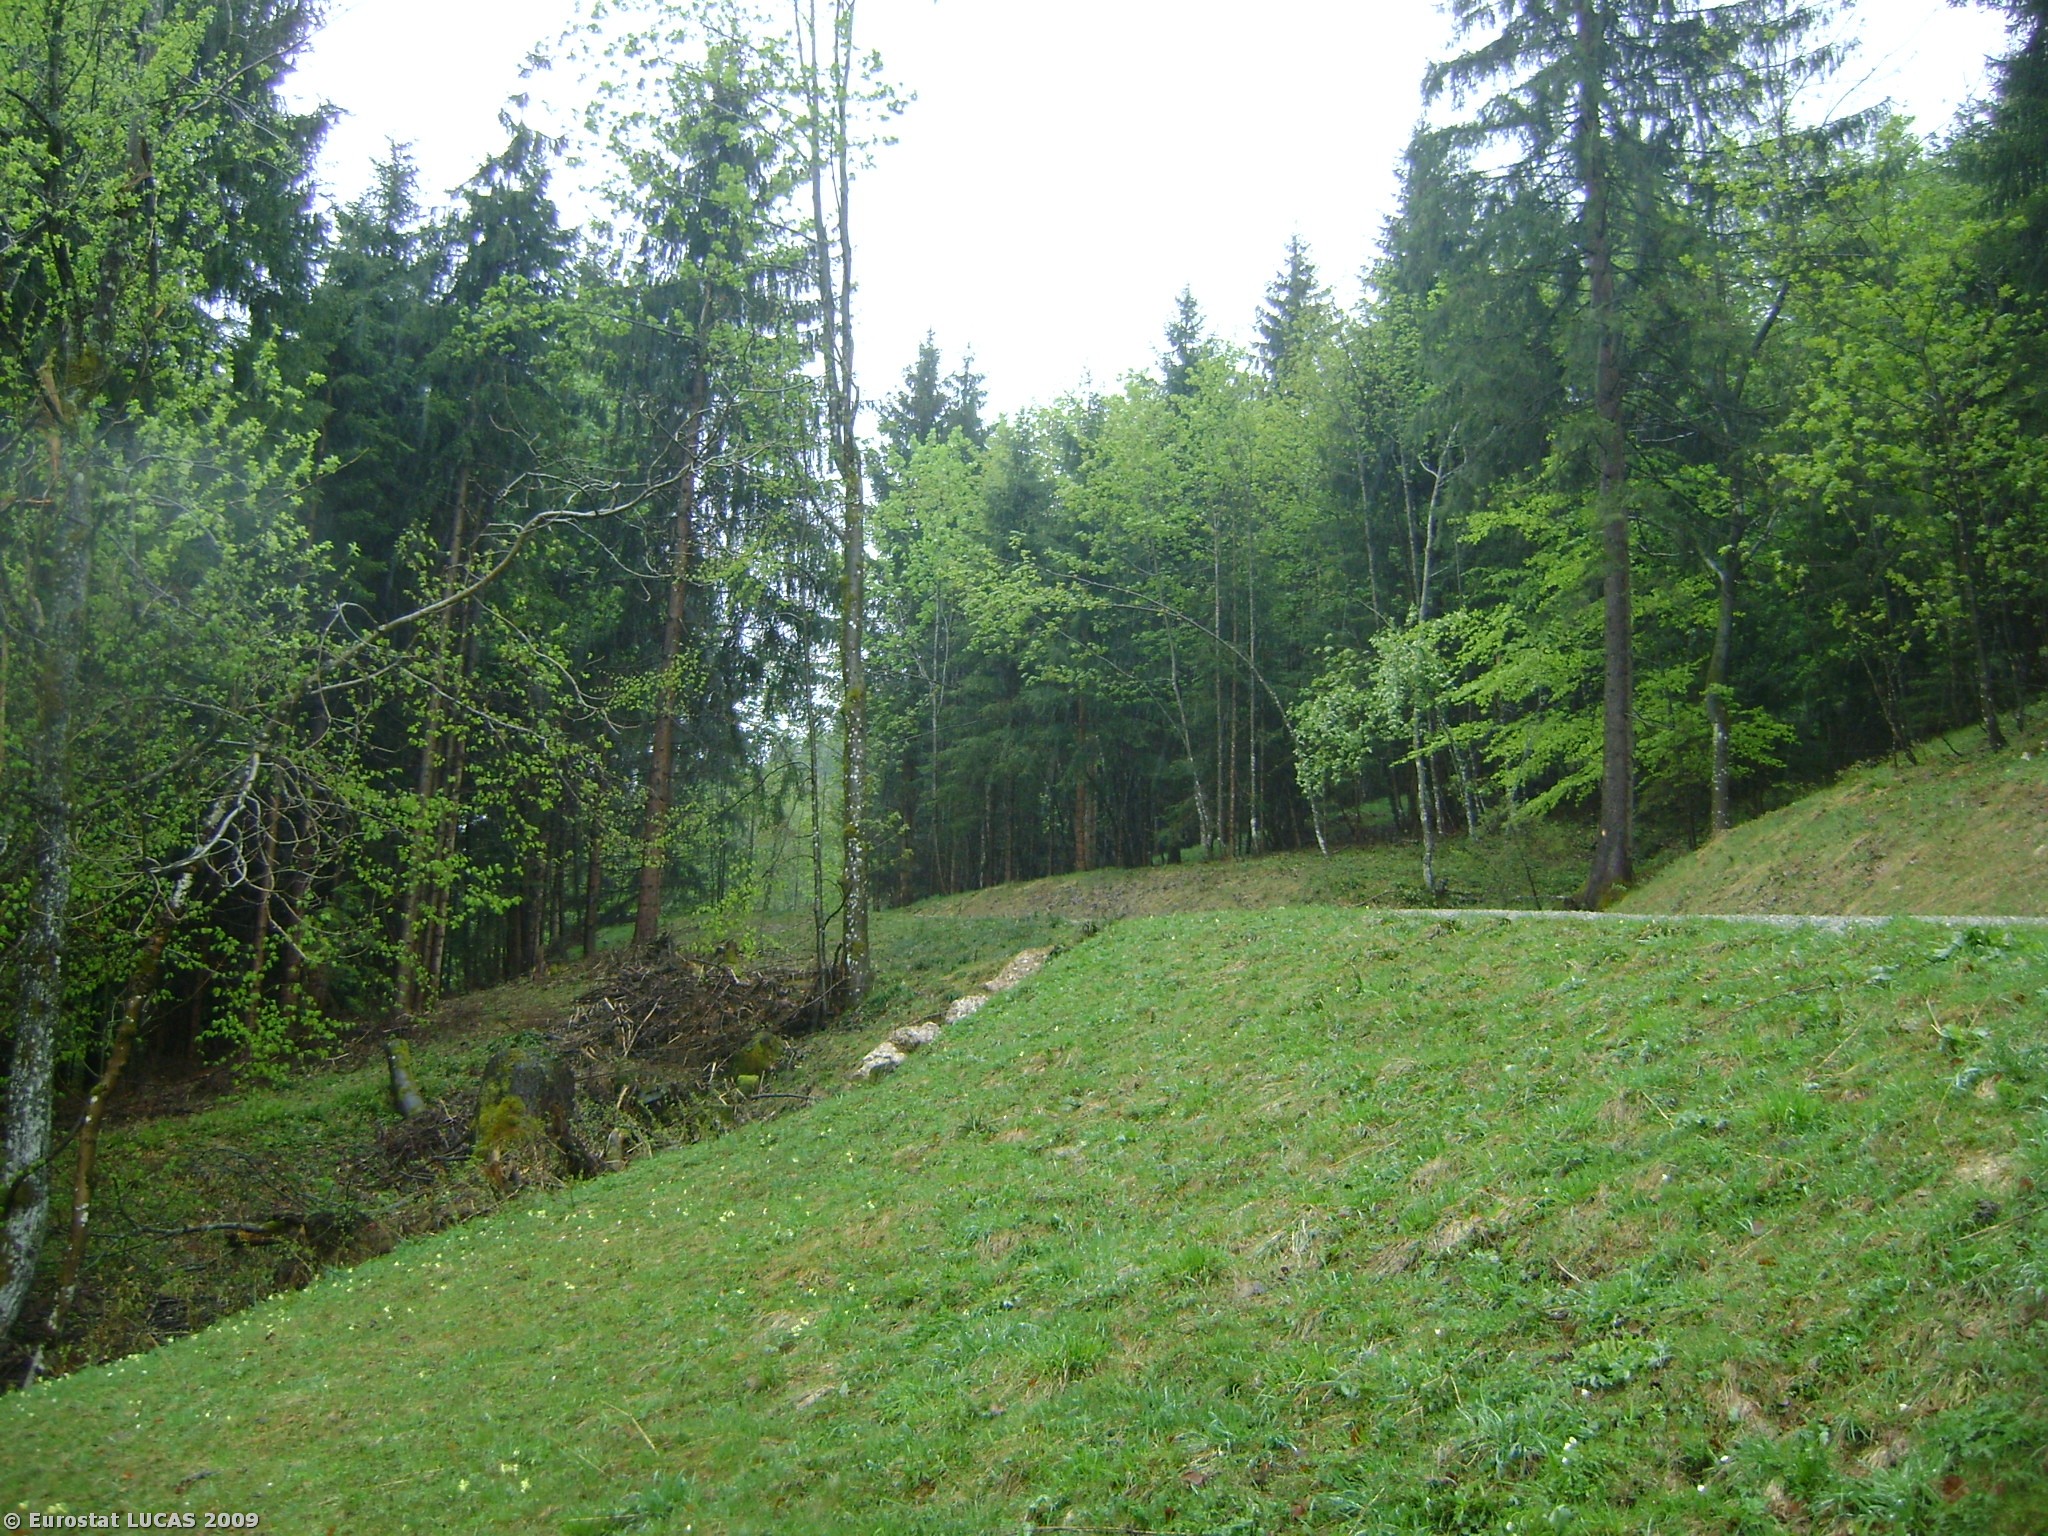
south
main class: Grassland
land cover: Grassland without tree/shrub cover
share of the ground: > 75 %
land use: Agriculture (excluding fallow land and kitchen gardens)
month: May
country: AT
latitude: 47.7976
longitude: 13.2429
